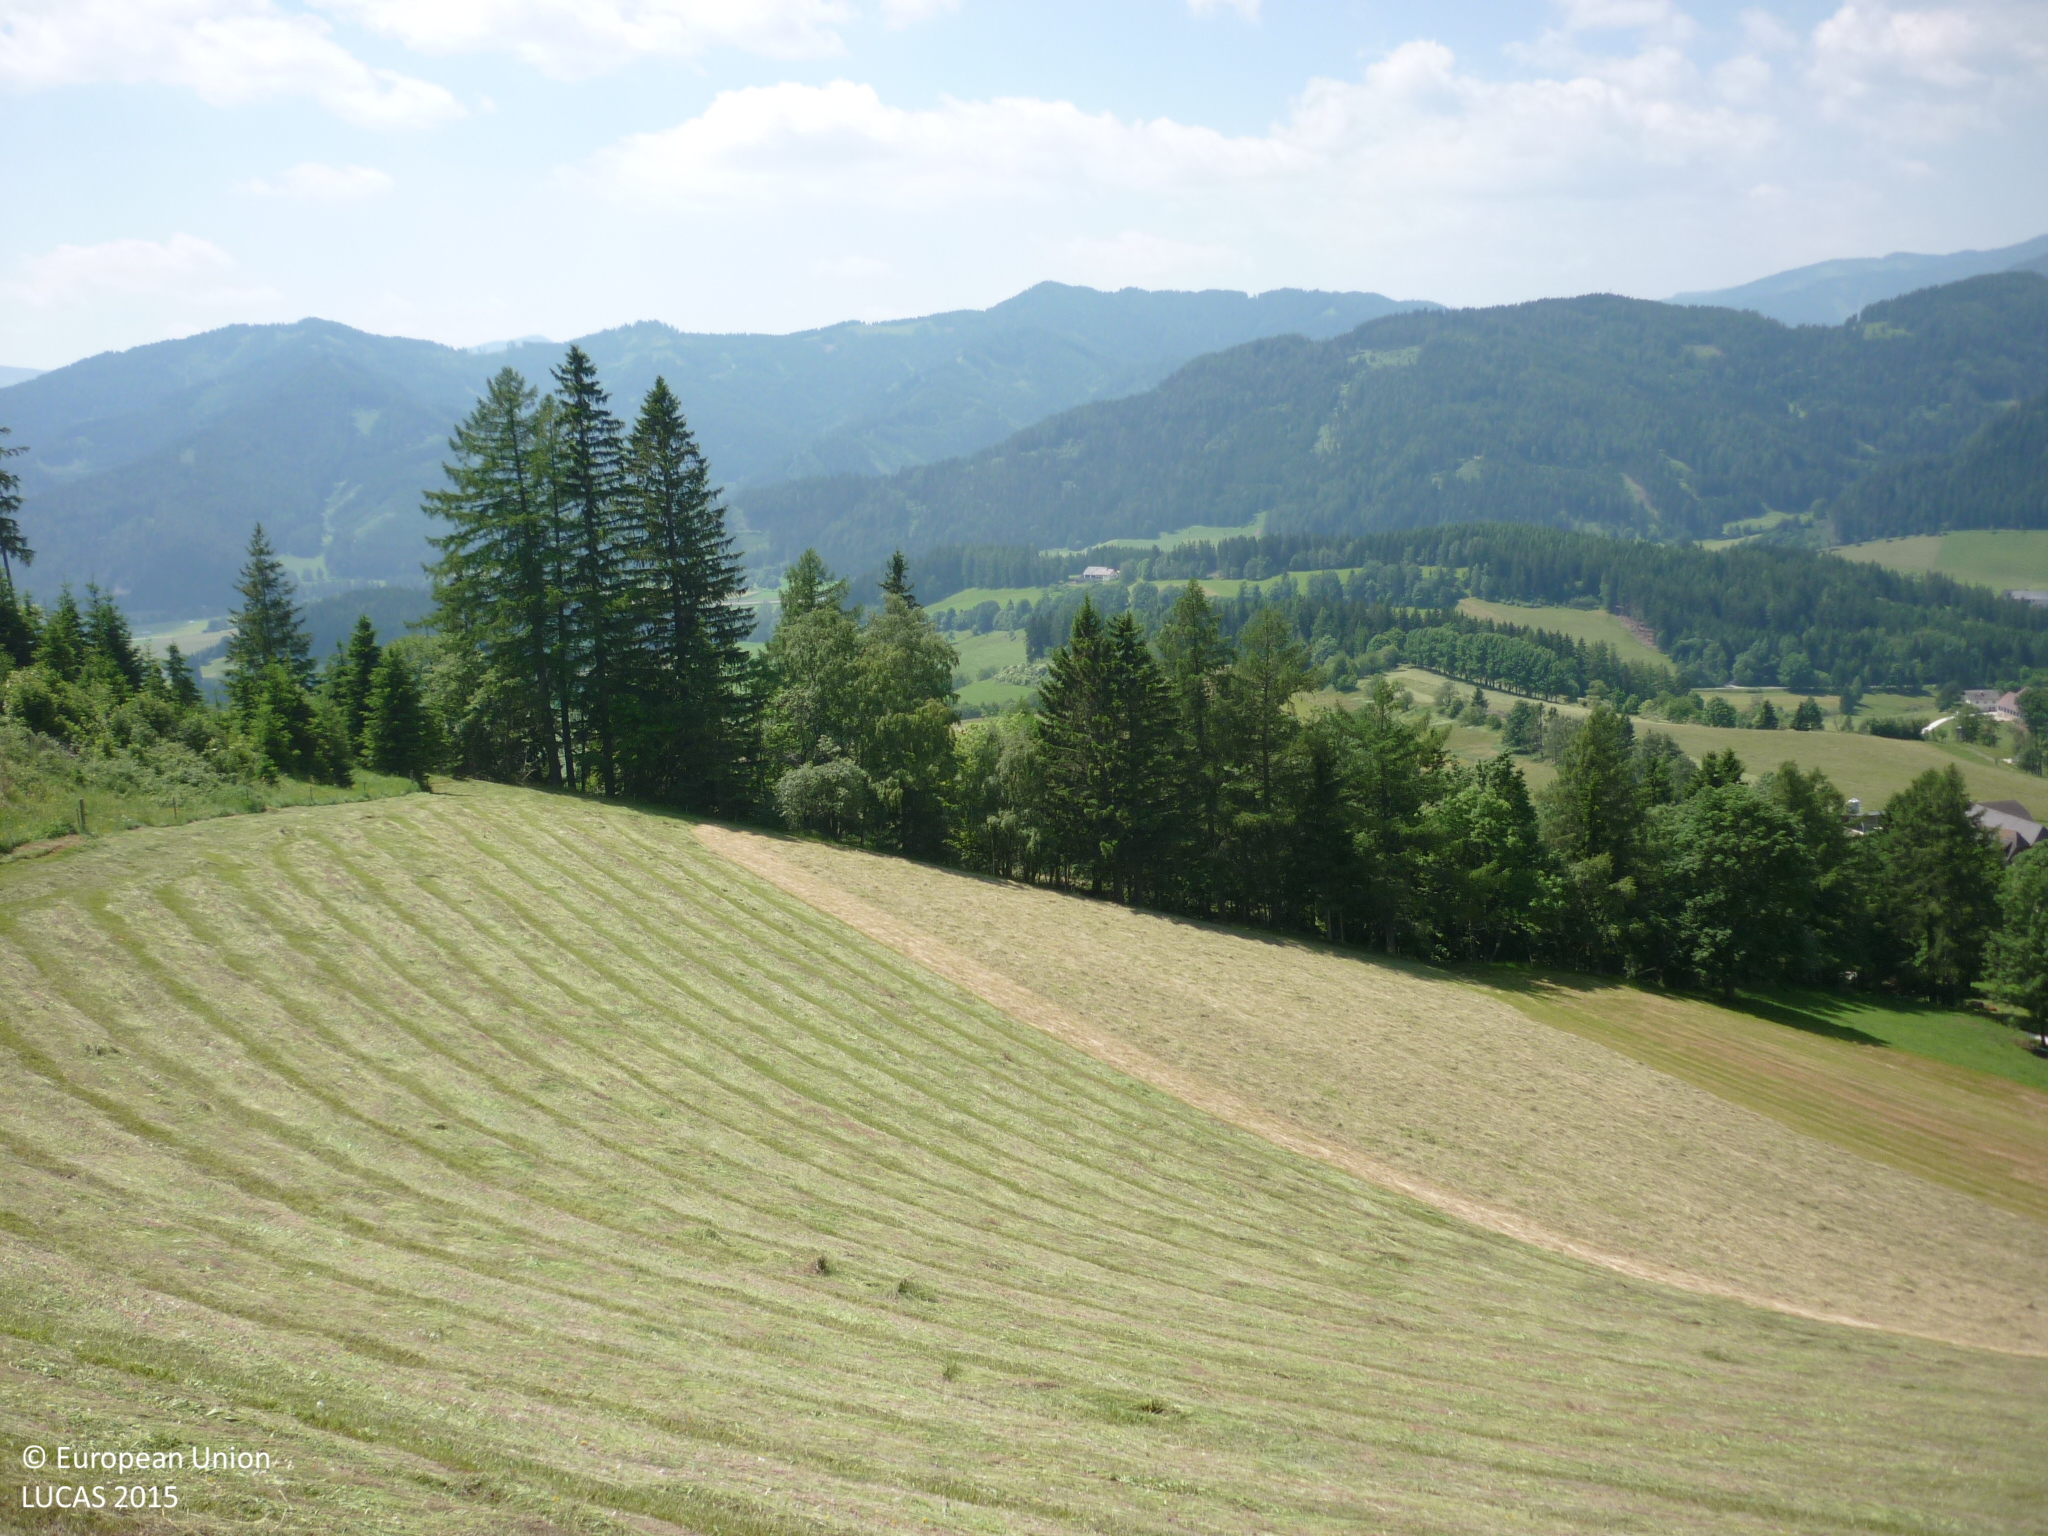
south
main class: Grassland
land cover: Grassland without tree/shrub cover
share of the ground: > 75 %
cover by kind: herbaceous plants 100 %
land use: Agriculture (excluding fallow land and kitchen gardens)
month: June
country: AT
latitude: 47.2842
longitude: 14.5073
